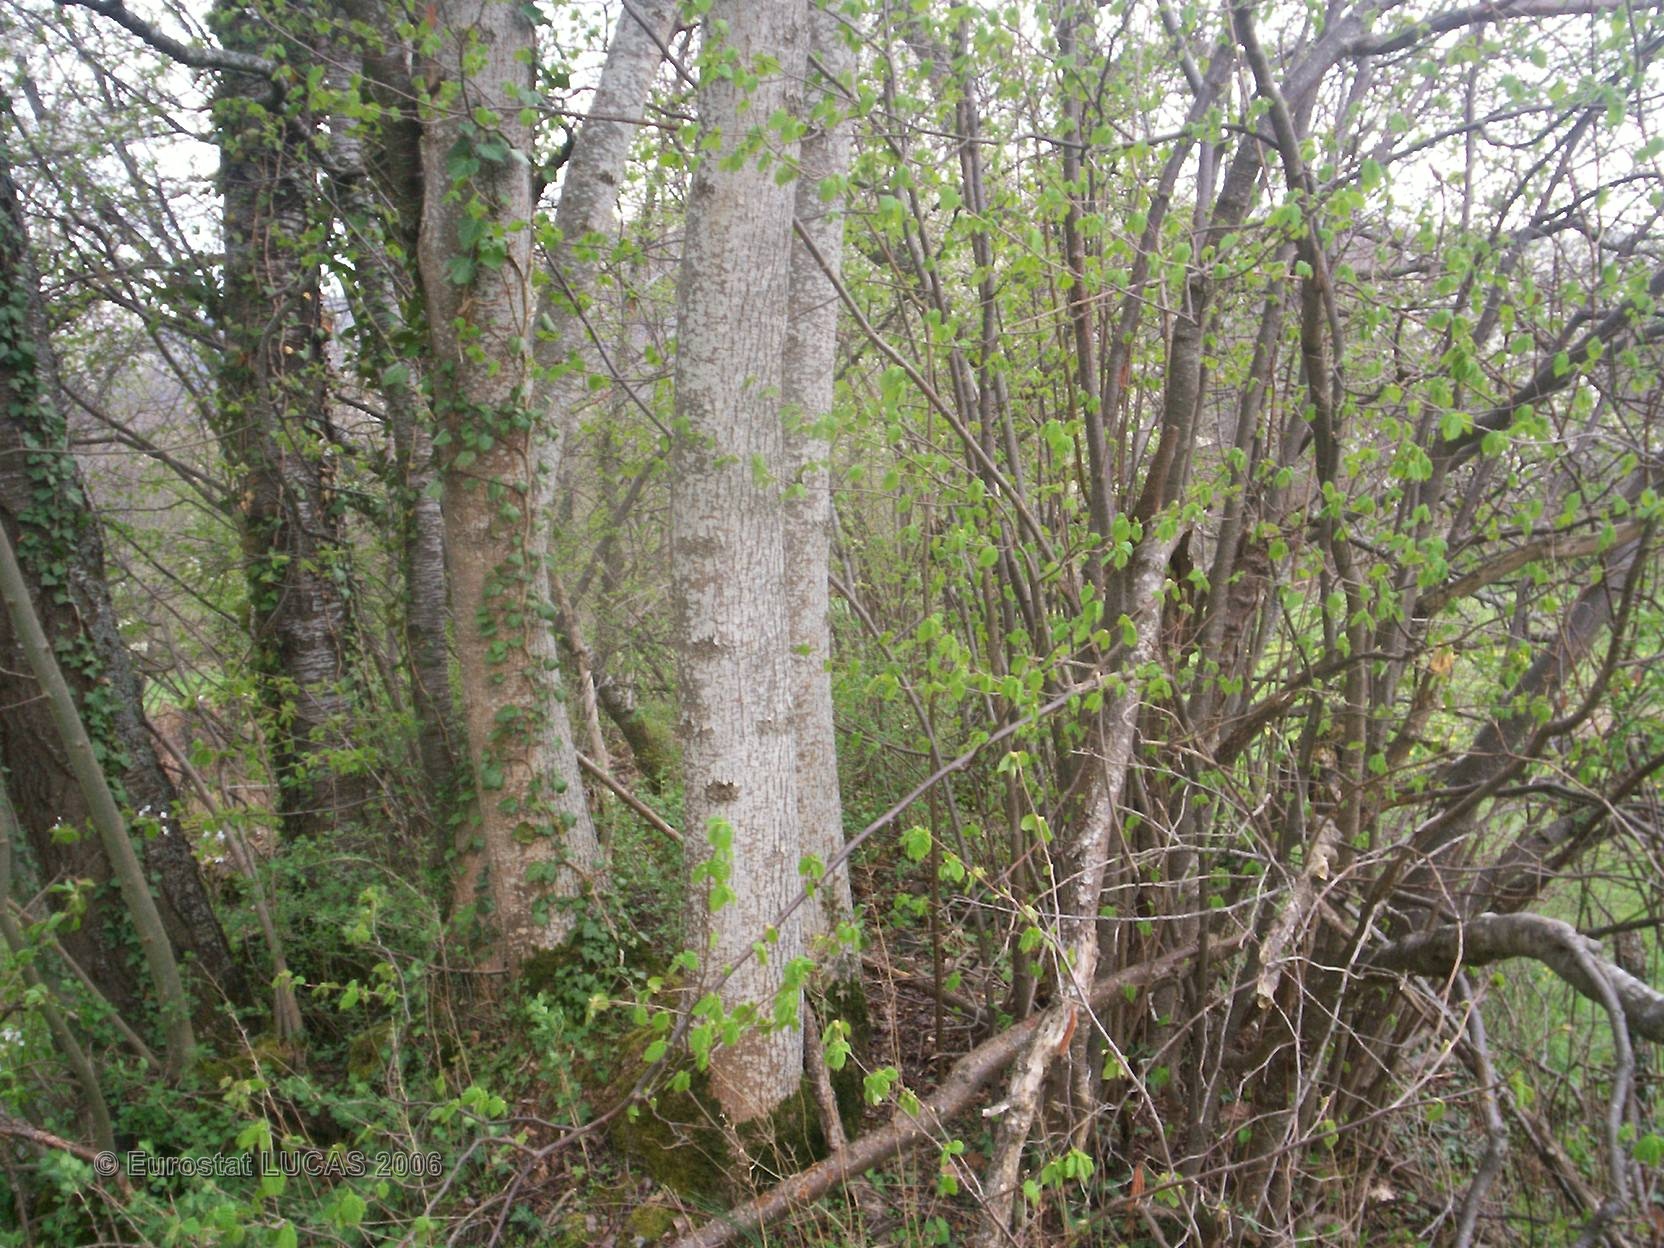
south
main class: Woodland
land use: Unused
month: April
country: FR
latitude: 45.5770
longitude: 2.9644
